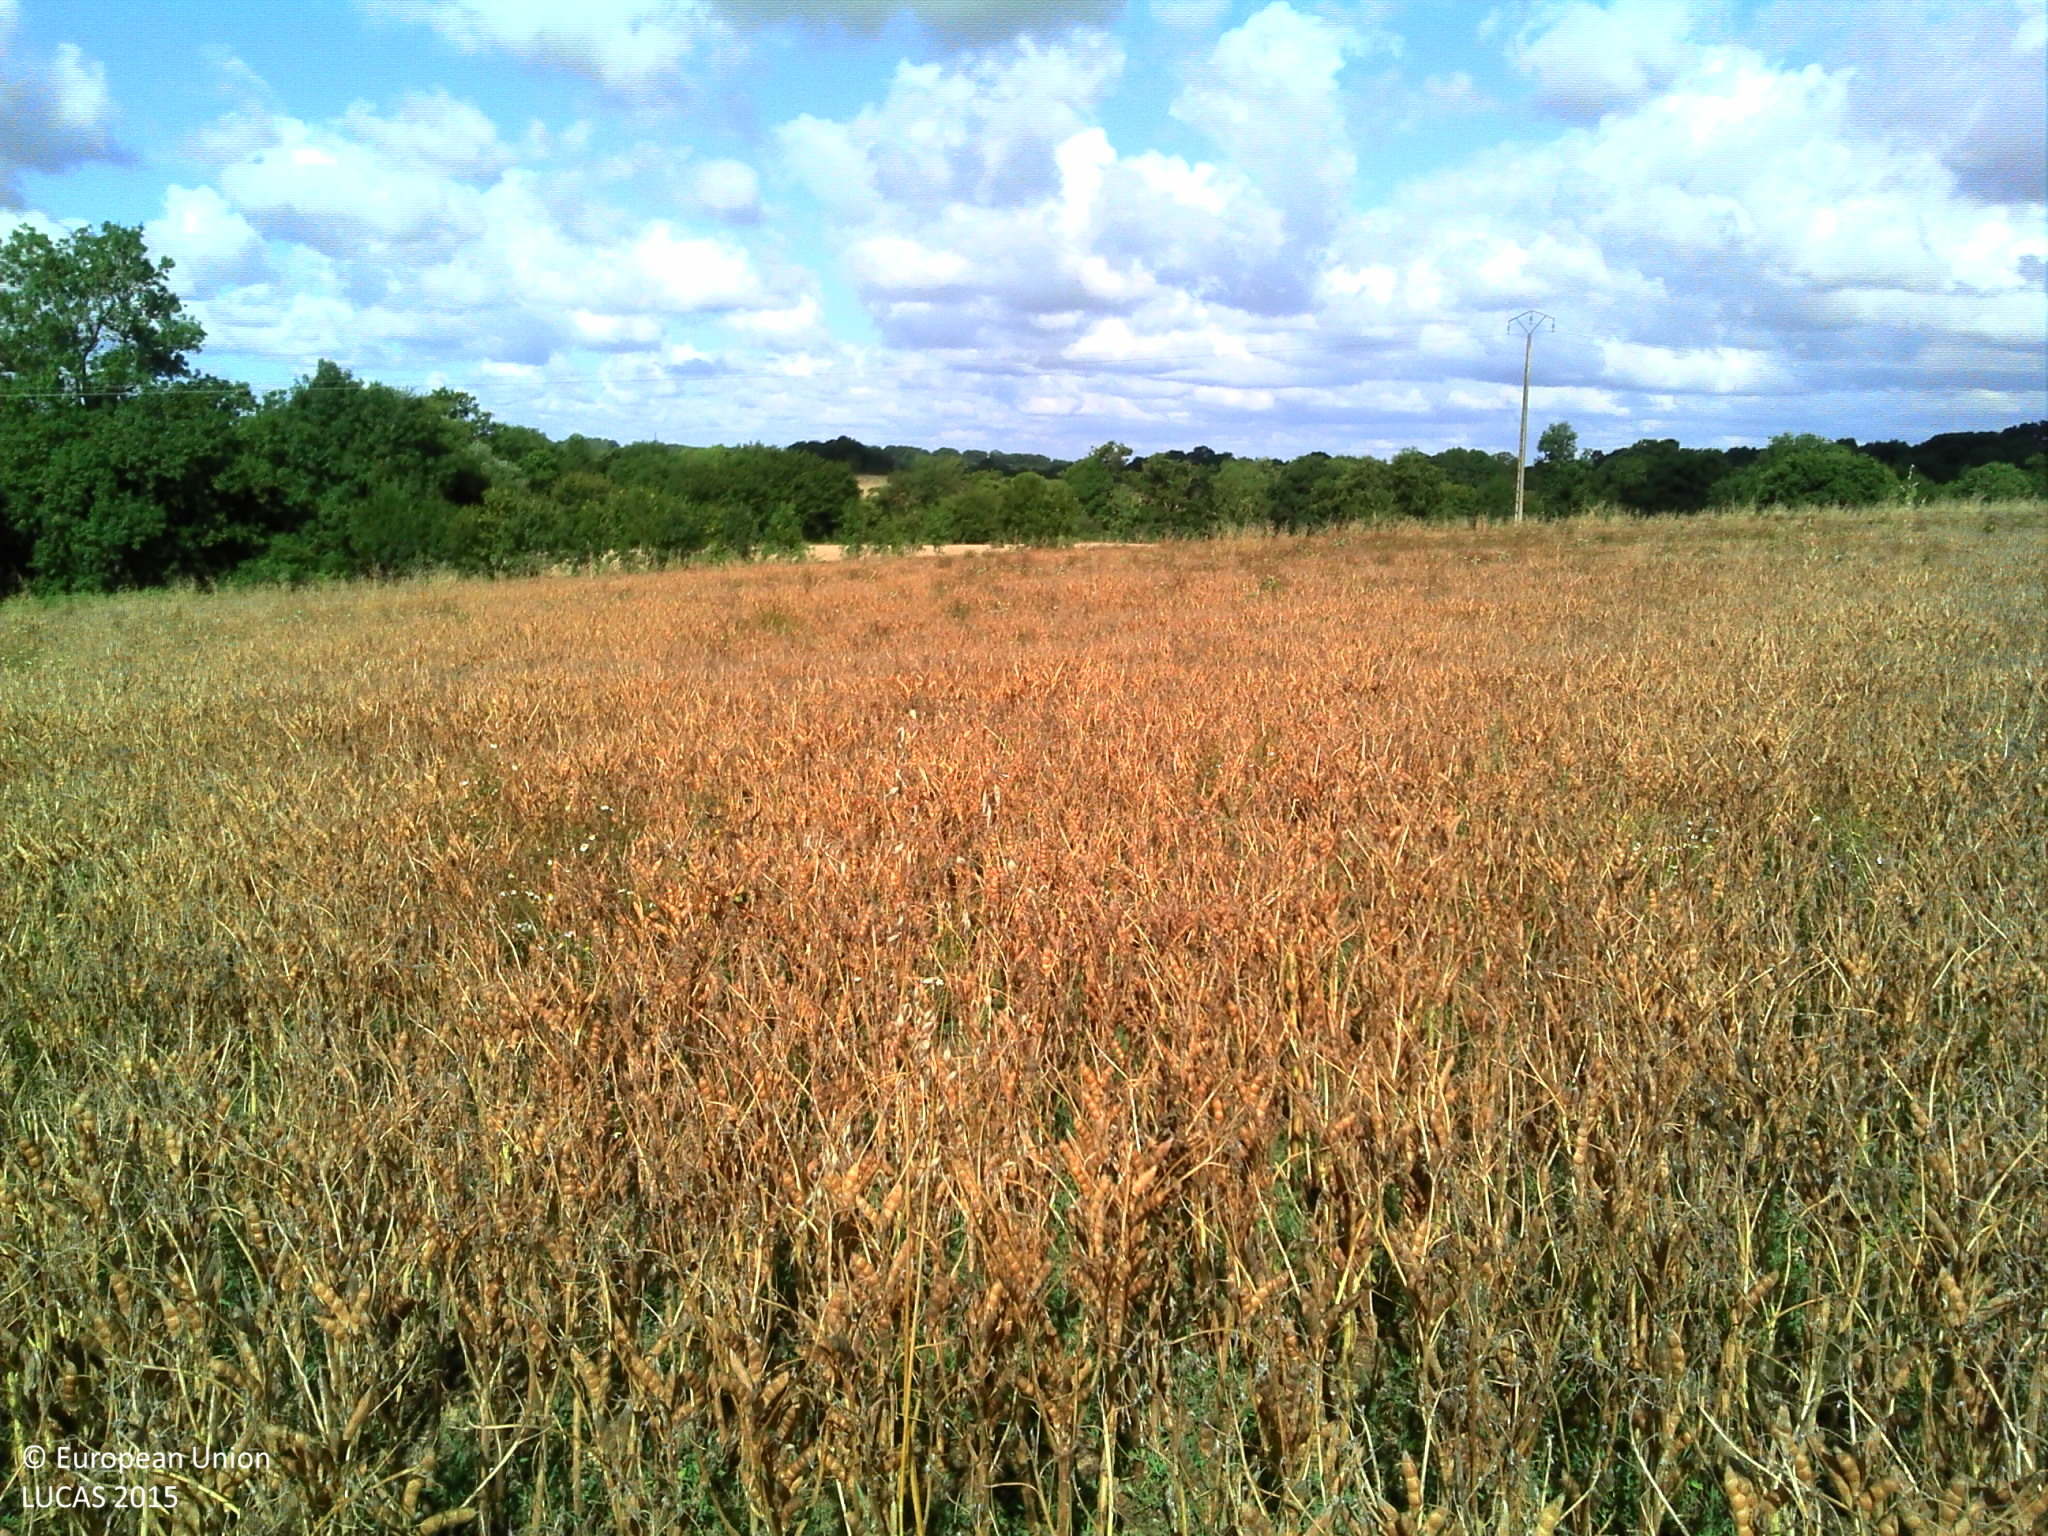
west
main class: Cropland
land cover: Dry pulses
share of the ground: > 75 %
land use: Agriculture (excluding fallow land and kitchen gardens)
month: July
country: FR
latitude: 47.6943
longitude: -1.6512
